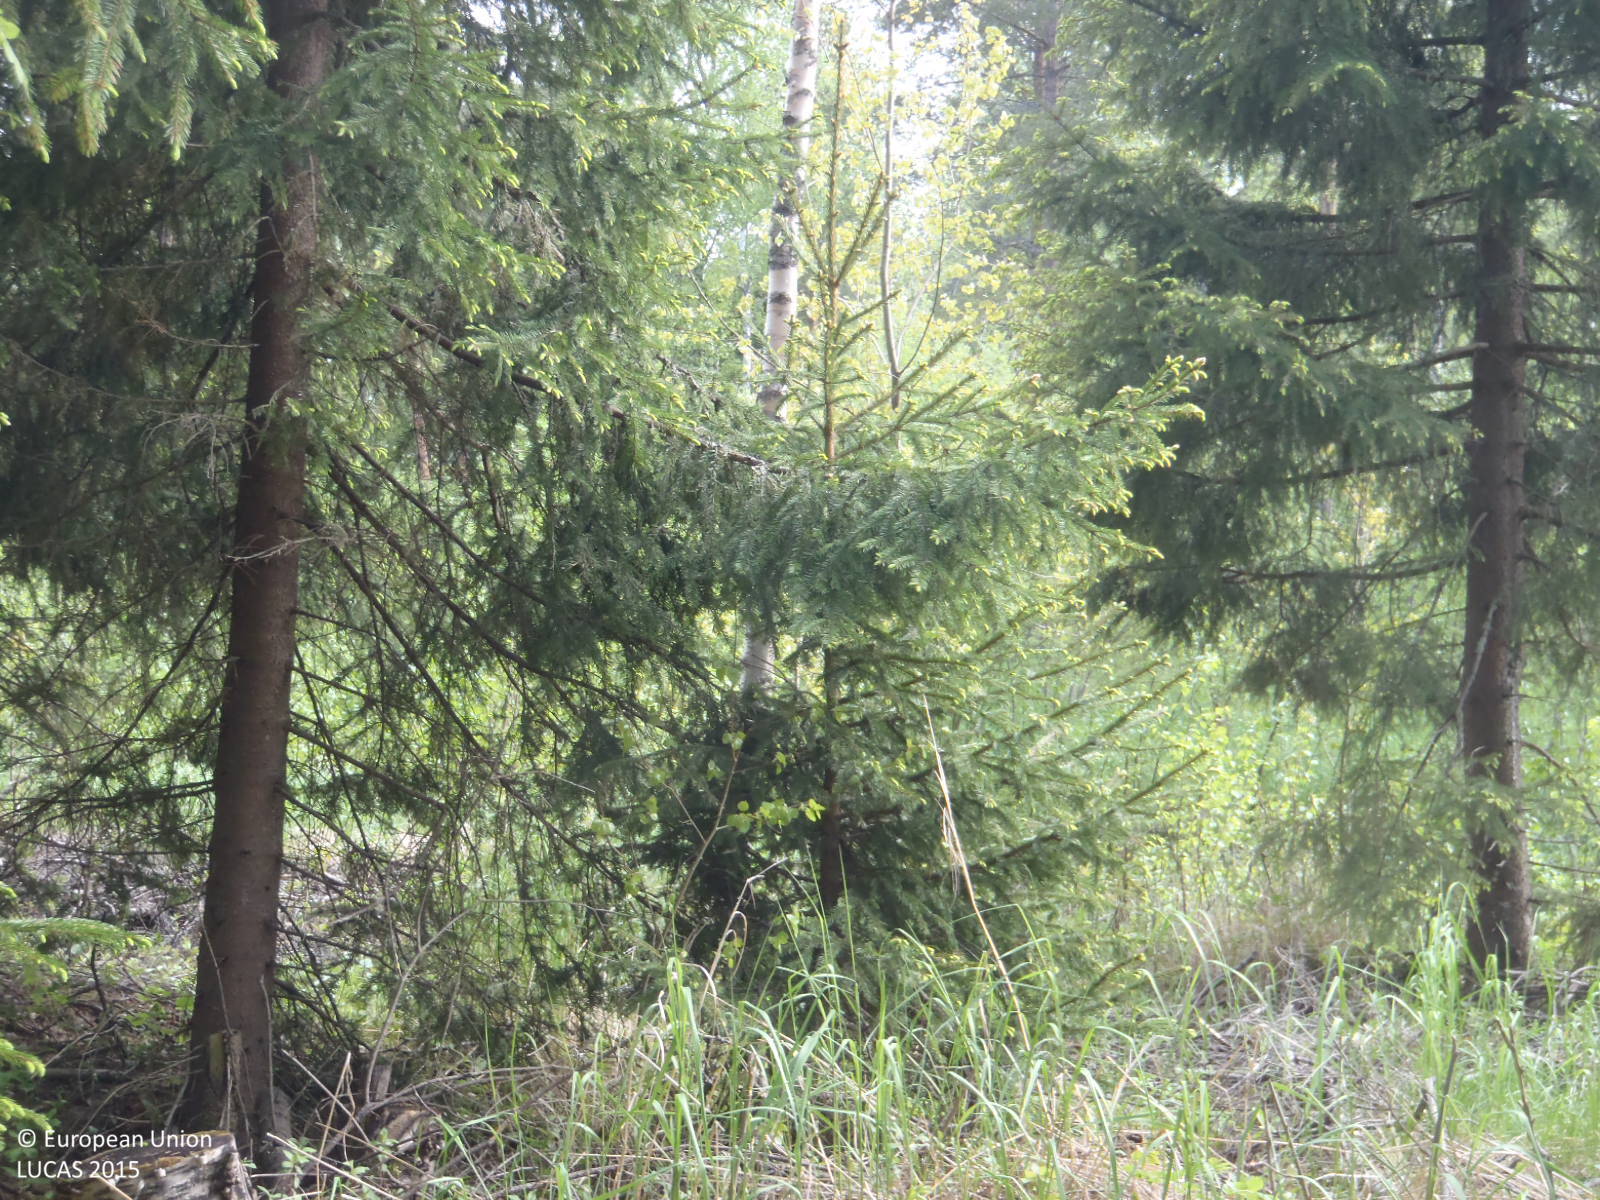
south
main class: Woodland
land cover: Other mixed woodland
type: boreal forest
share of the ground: > 75 %
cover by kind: broadleaved forest trees 40 %, coniferous forest trees 35 %, shrubs 20 %, herbaceous plants 5 %
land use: Forestry
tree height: > 5 m
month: June
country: FI
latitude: 64.9553
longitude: 25.5620
